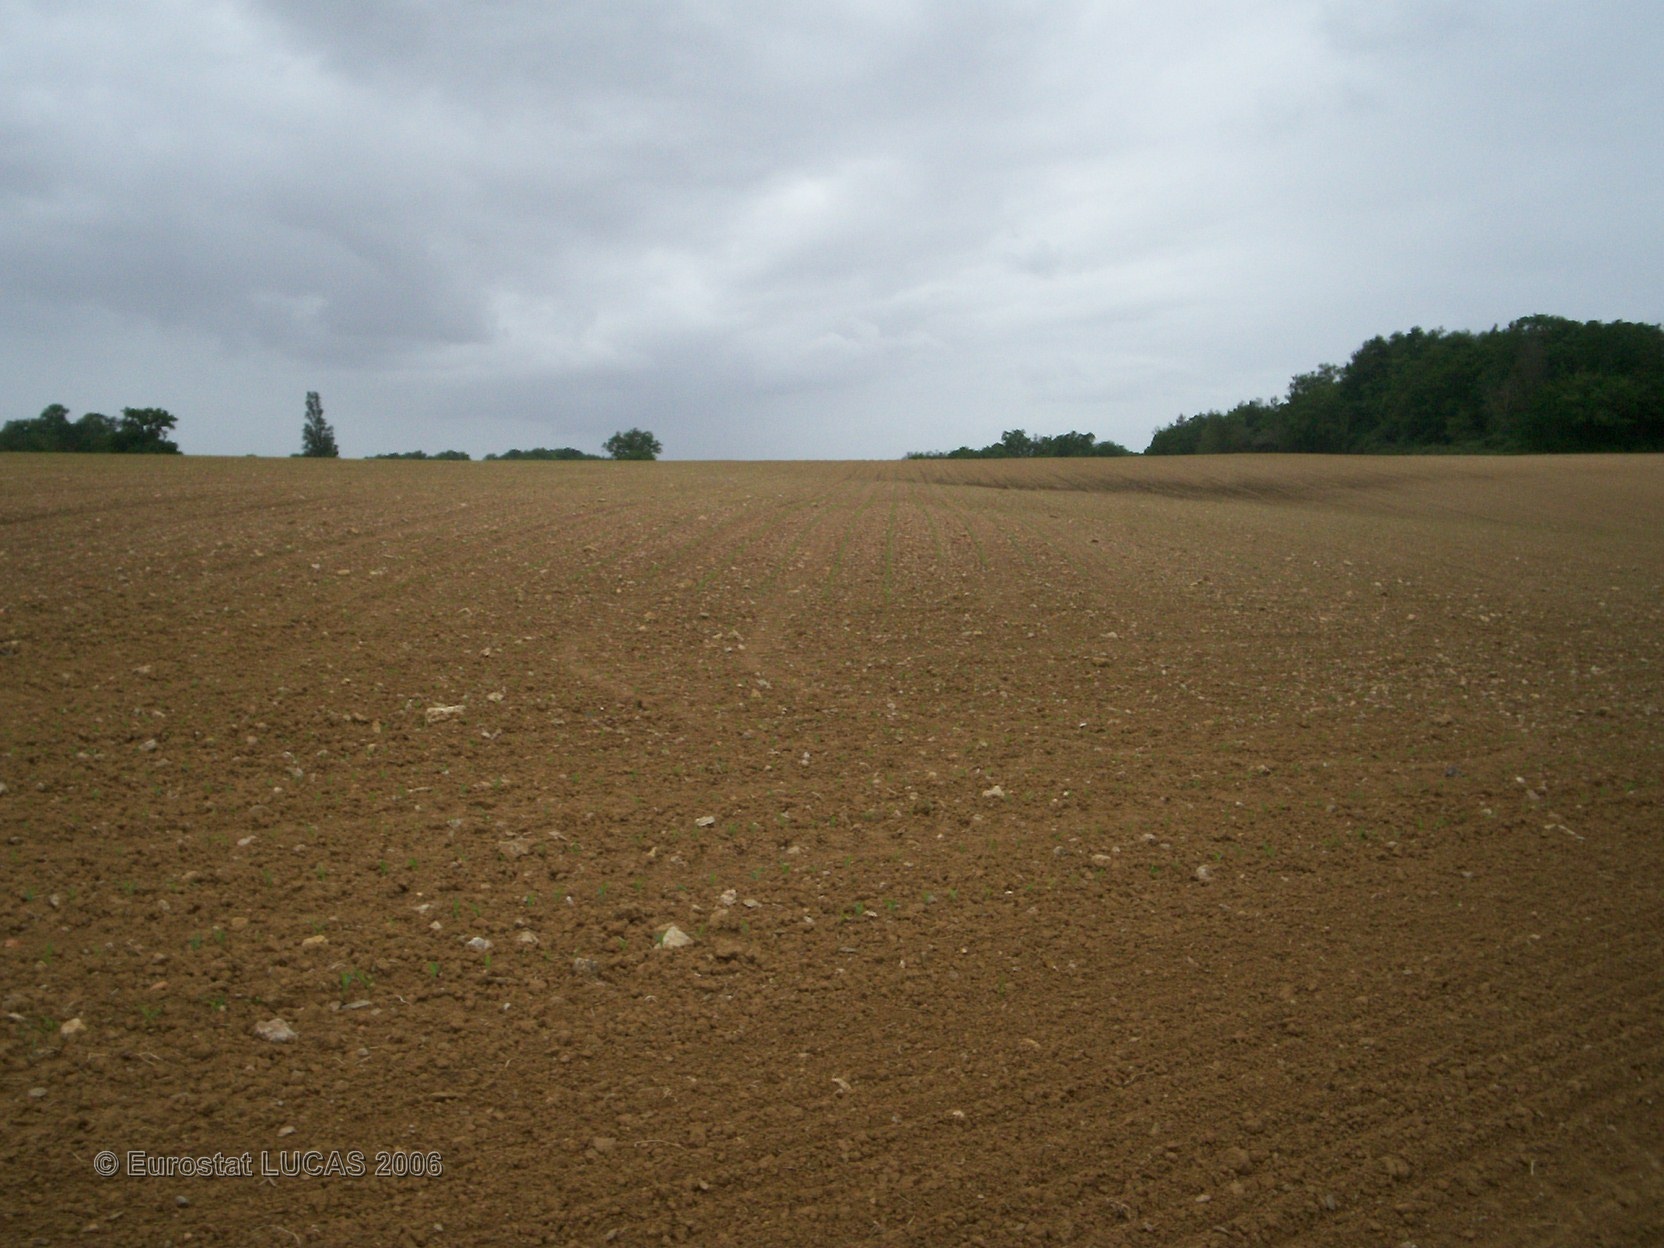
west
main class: Grassland
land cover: Grassland without tree/shrub cover
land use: Agriculture (excluding fallow land and kitchen gardens)
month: May
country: FR
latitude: 46.5077
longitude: -0.8337
